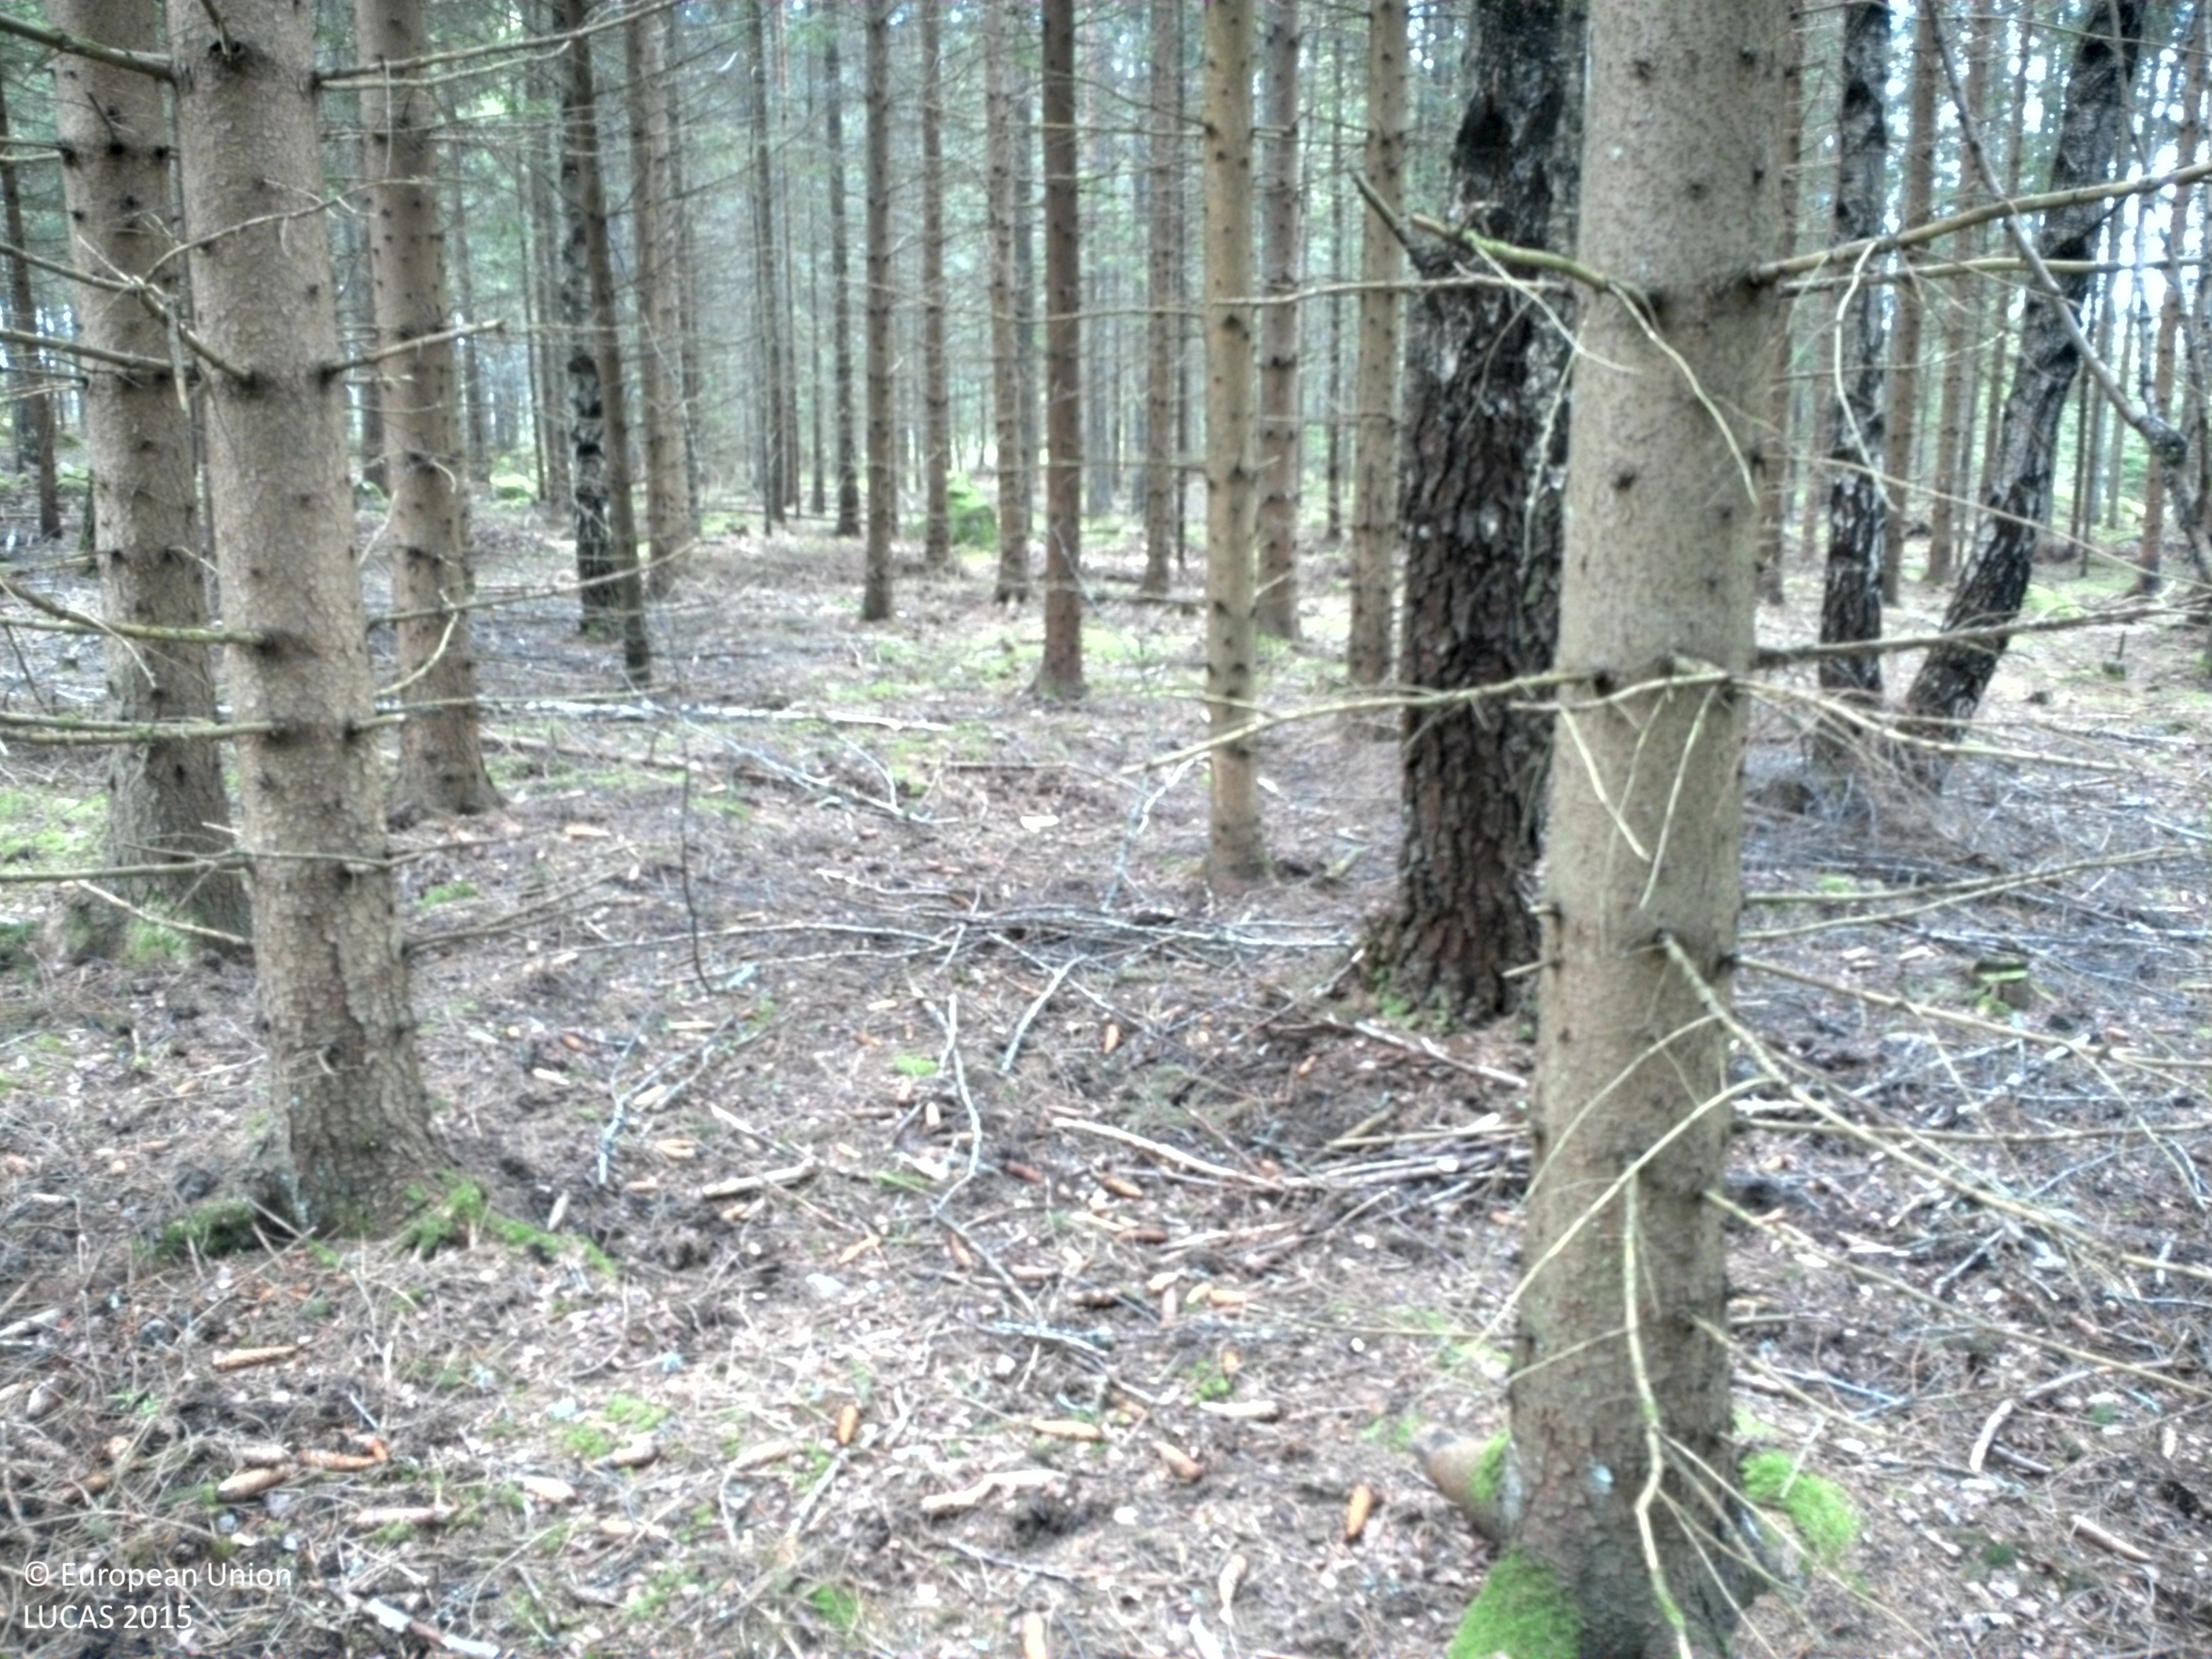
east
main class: Woodland
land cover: Spruce dominated coniferous woodland
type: boreal forest
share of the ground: > 75 %
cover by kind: coniferous forest trees 95 %, broadleaved forest trees 5 %
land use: Forestry
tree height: > 5 m
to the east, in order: Spruce dominated coniferous woodland; Broadleaved woodland; Spruce dominated coniferous woodland
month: May
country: SE
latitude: 56.4884
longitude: 15.4069
